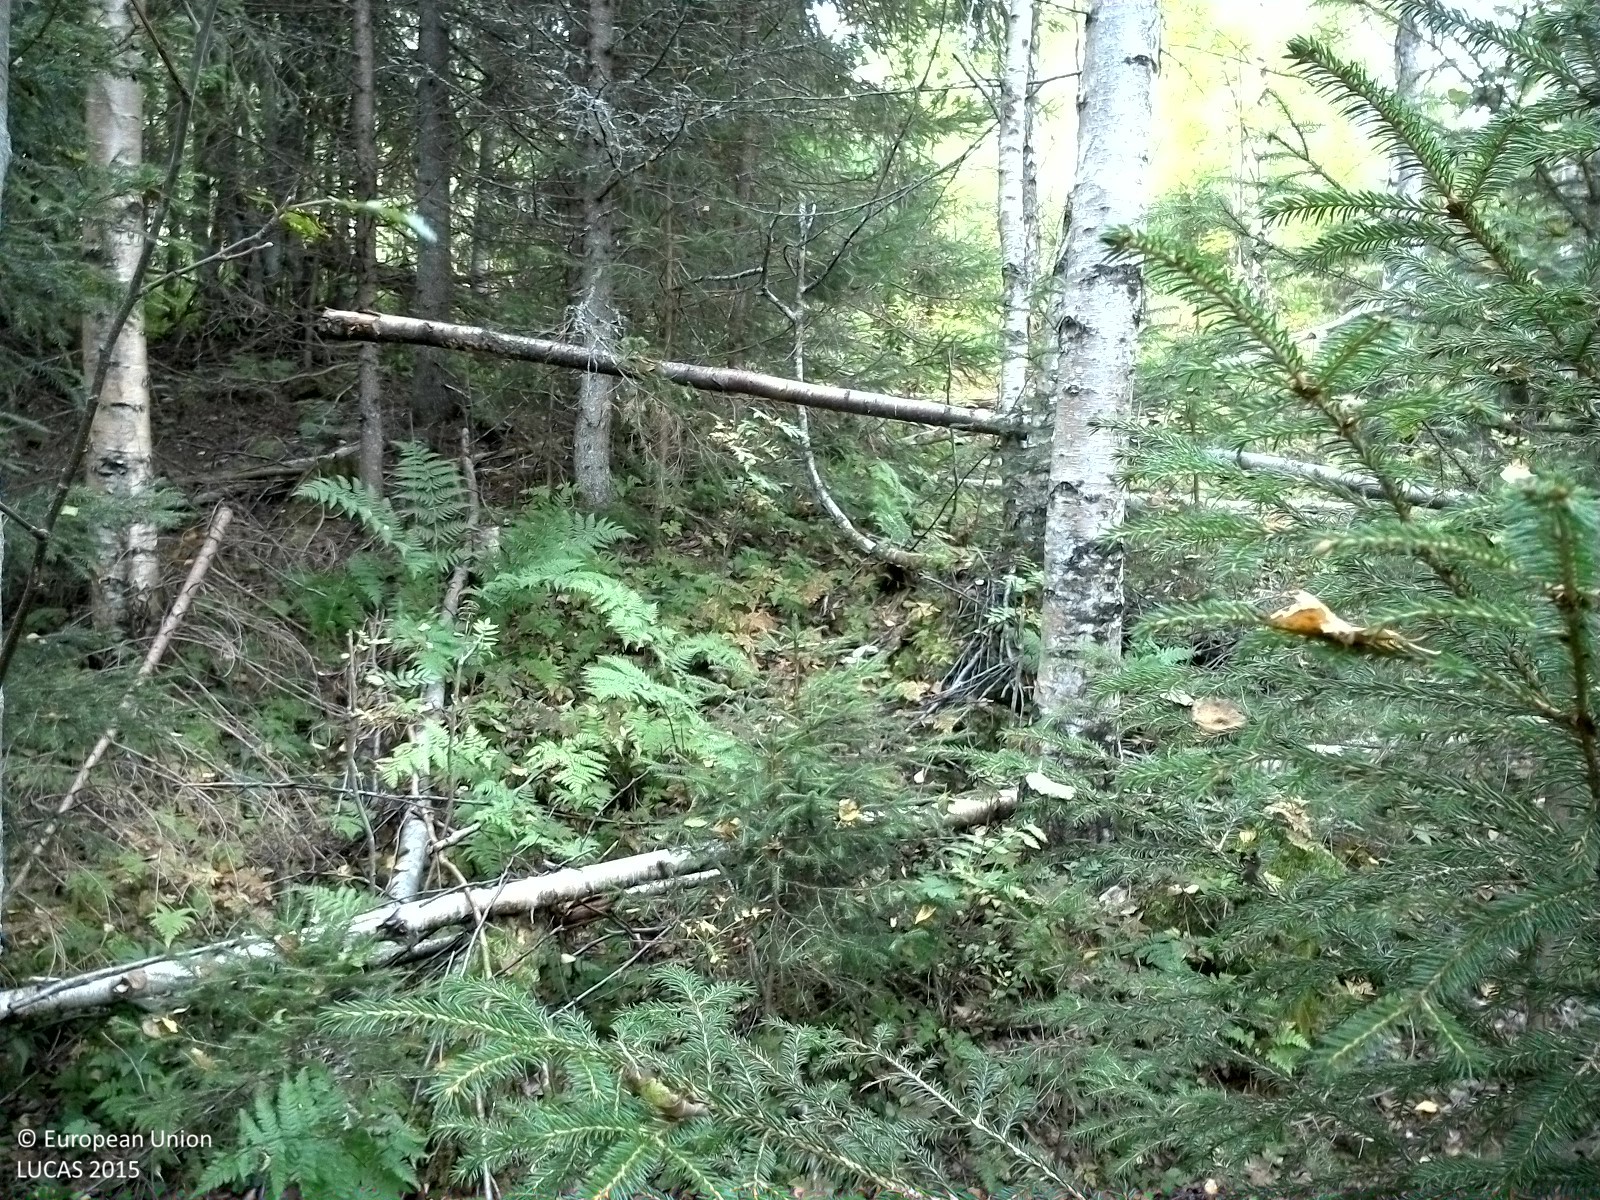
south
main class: Woodland
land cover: Broadleaved woodland
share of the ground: > 75 %
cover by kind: broadleaved forest trees 75 %, coniferous forest trees 15 %, shrubs 10 %
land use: Forestry
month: September
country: SE
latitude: 62.6231
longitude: 16.3527
